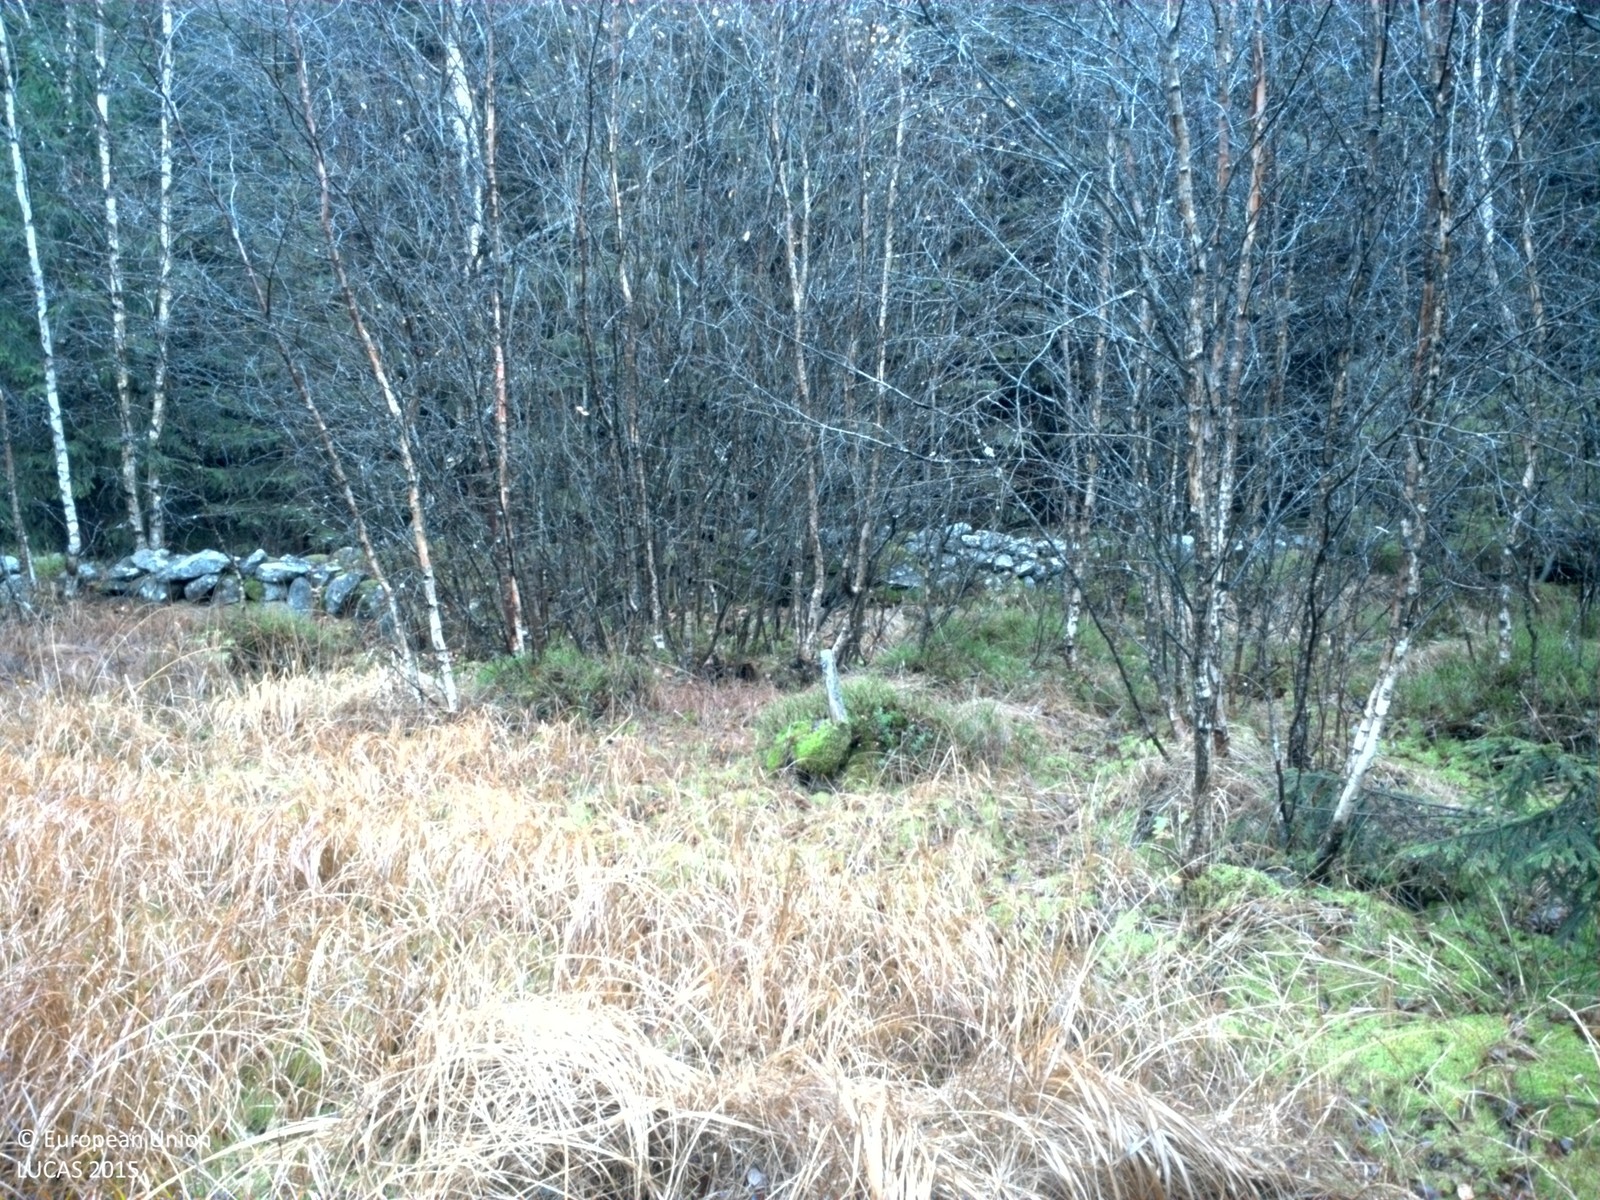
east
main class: Woodland
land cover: Broadleaved woodland
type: hemiboreal forest and nemoral coniferous forest and mixed broadleaved-coniferous forest
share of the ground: 50 - 75 %
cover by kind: broadleaved forest trees 55 %, herbaceous plants 30 %, coniferous forest trees 10 %, shrubs 5 %
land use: Forestry
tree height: < 5 m
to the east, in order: Broadleaved woodland; Dry stone walls; Spruce dominated coniferous woodland; Tracks; Spruce dominated coniferous woodland; Other coniferous woodland; Paved roads, cycling and walking lanes; Spruce dominated coniferous woodland
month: November
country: SE
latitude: 56.0410
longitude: 13.1597
